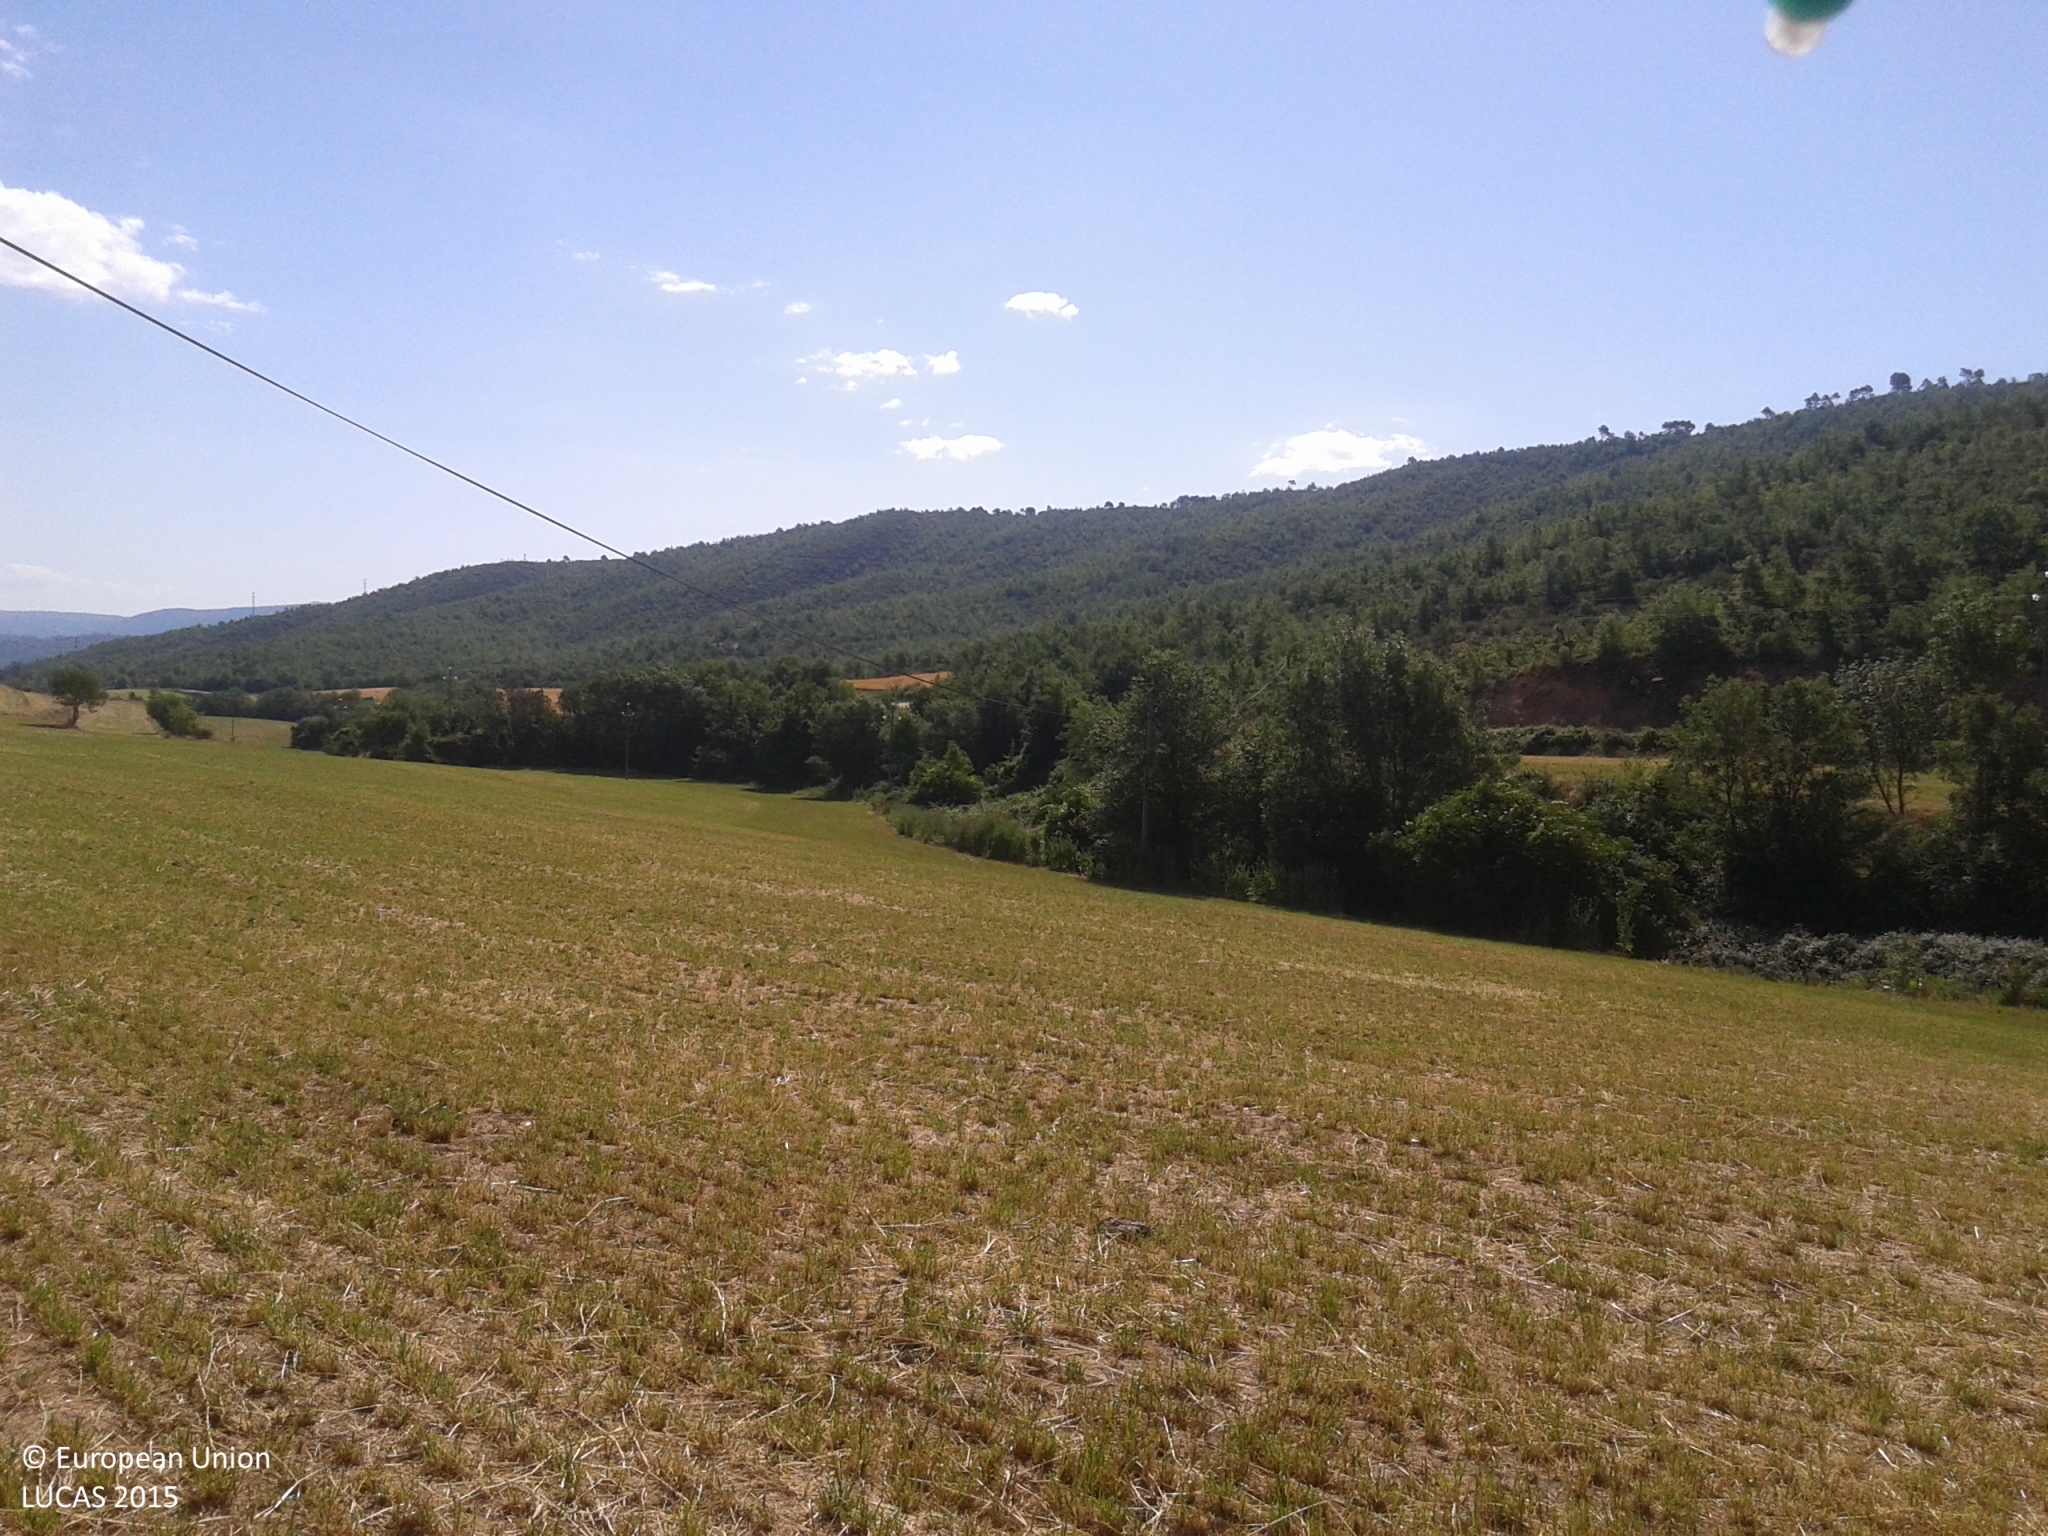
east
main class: Cropland
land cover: Rye
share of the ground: < 10 %
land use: Agriculture (excluding fallow land and kitchen gardens)
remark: Harvested field
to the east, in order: Rye; Electric lines; Rye; Broadleaved woodland; Electric lines; Broadleaved woodland; Electric lines; Broadleaved woodland; Barley; Fences; Grass margins; Paved roads, cycling and walking lanes; Grassland with sparse tree/shrub cover; Fences; Barley
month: May
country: ES
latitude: 41.9082
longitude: 1.6349
